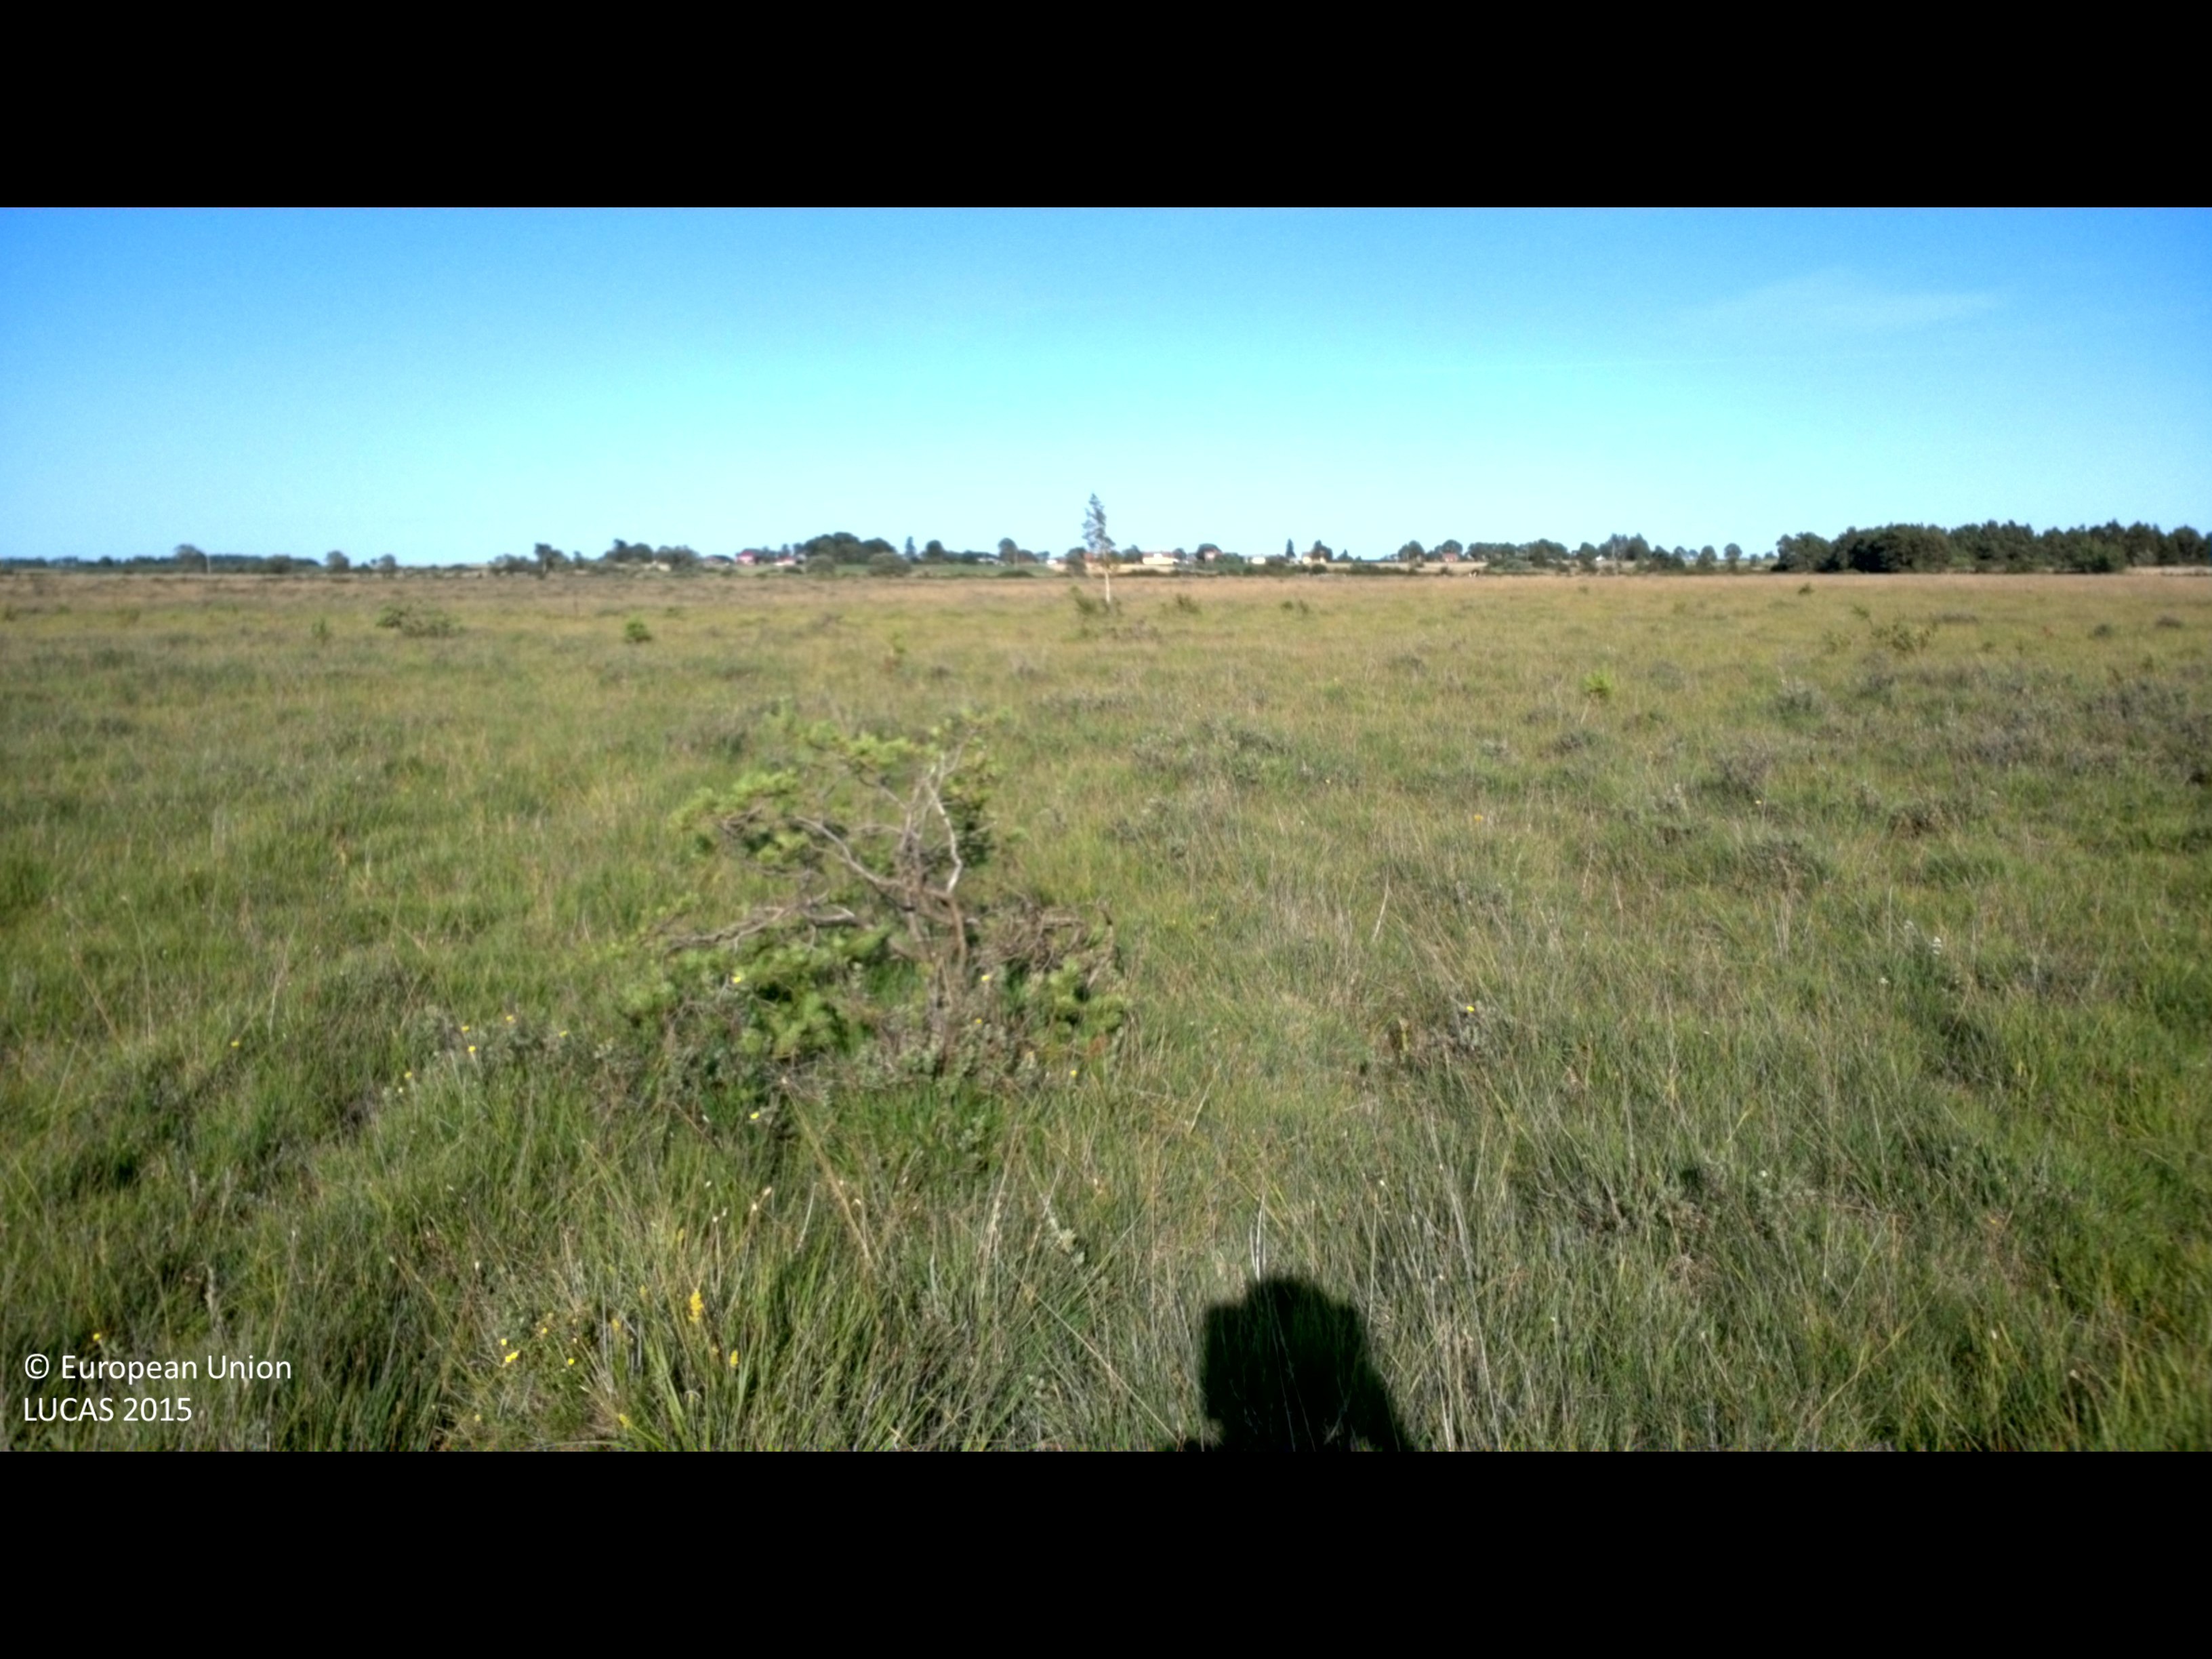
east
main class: Grassland
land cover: Grassland without tree/shrub cover
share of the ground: > 75 %
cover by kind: herbaceous plants 100 %
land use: Agriculture (excluding fallow land and kitchen gardens)
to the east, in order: Grassland without tree/shrub cover; Sand; Grassland without tree/shrub cover
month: July
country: SE
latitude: 56.5239
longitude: 16.5855
